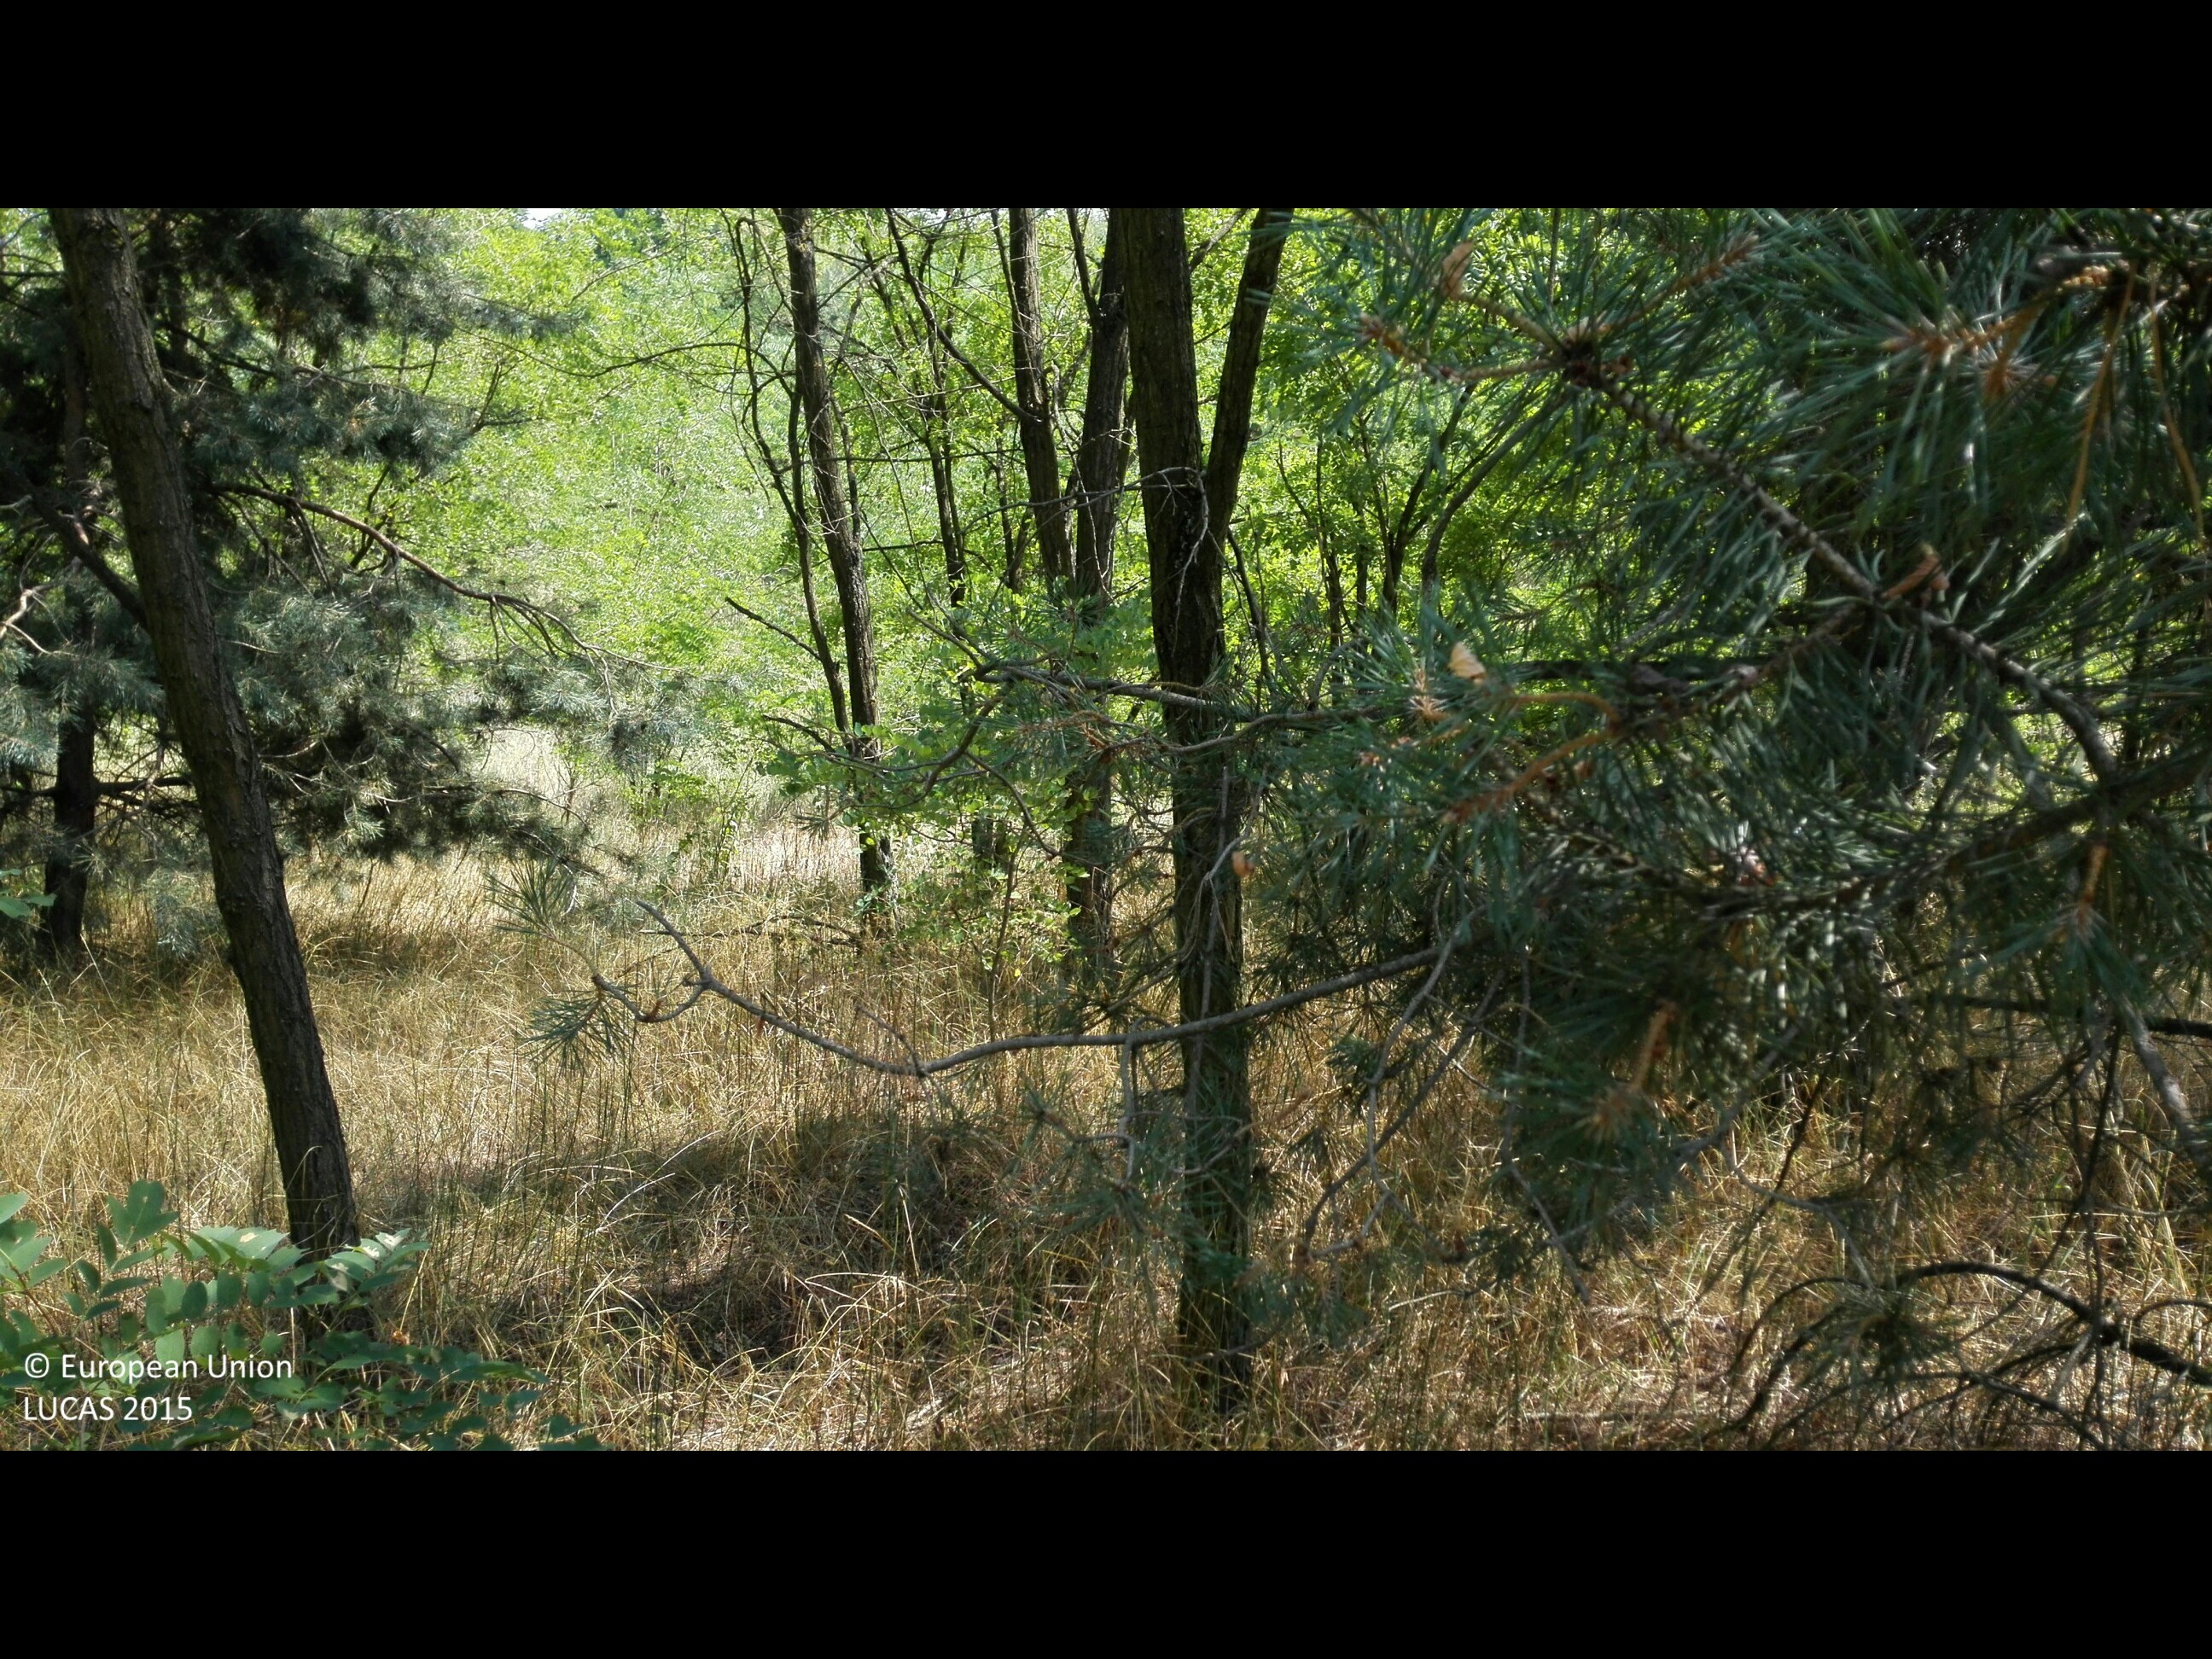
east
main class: Woodland
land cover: Broadleaved woodland
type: exotic forest
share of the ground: > 75 %
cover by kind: broadleaved forest trees 85 %, coniferous forest trees 10 %, herbaceous plants 5 %
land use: Forestry
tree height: > 5 m
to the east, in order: Broadleaved woodland; Grassland with sparse tree/shrub cover; Broadleaved woodland; Grassland without tree/shrub cover
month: August
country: HU
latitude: 47.5950
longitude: 22.0601
